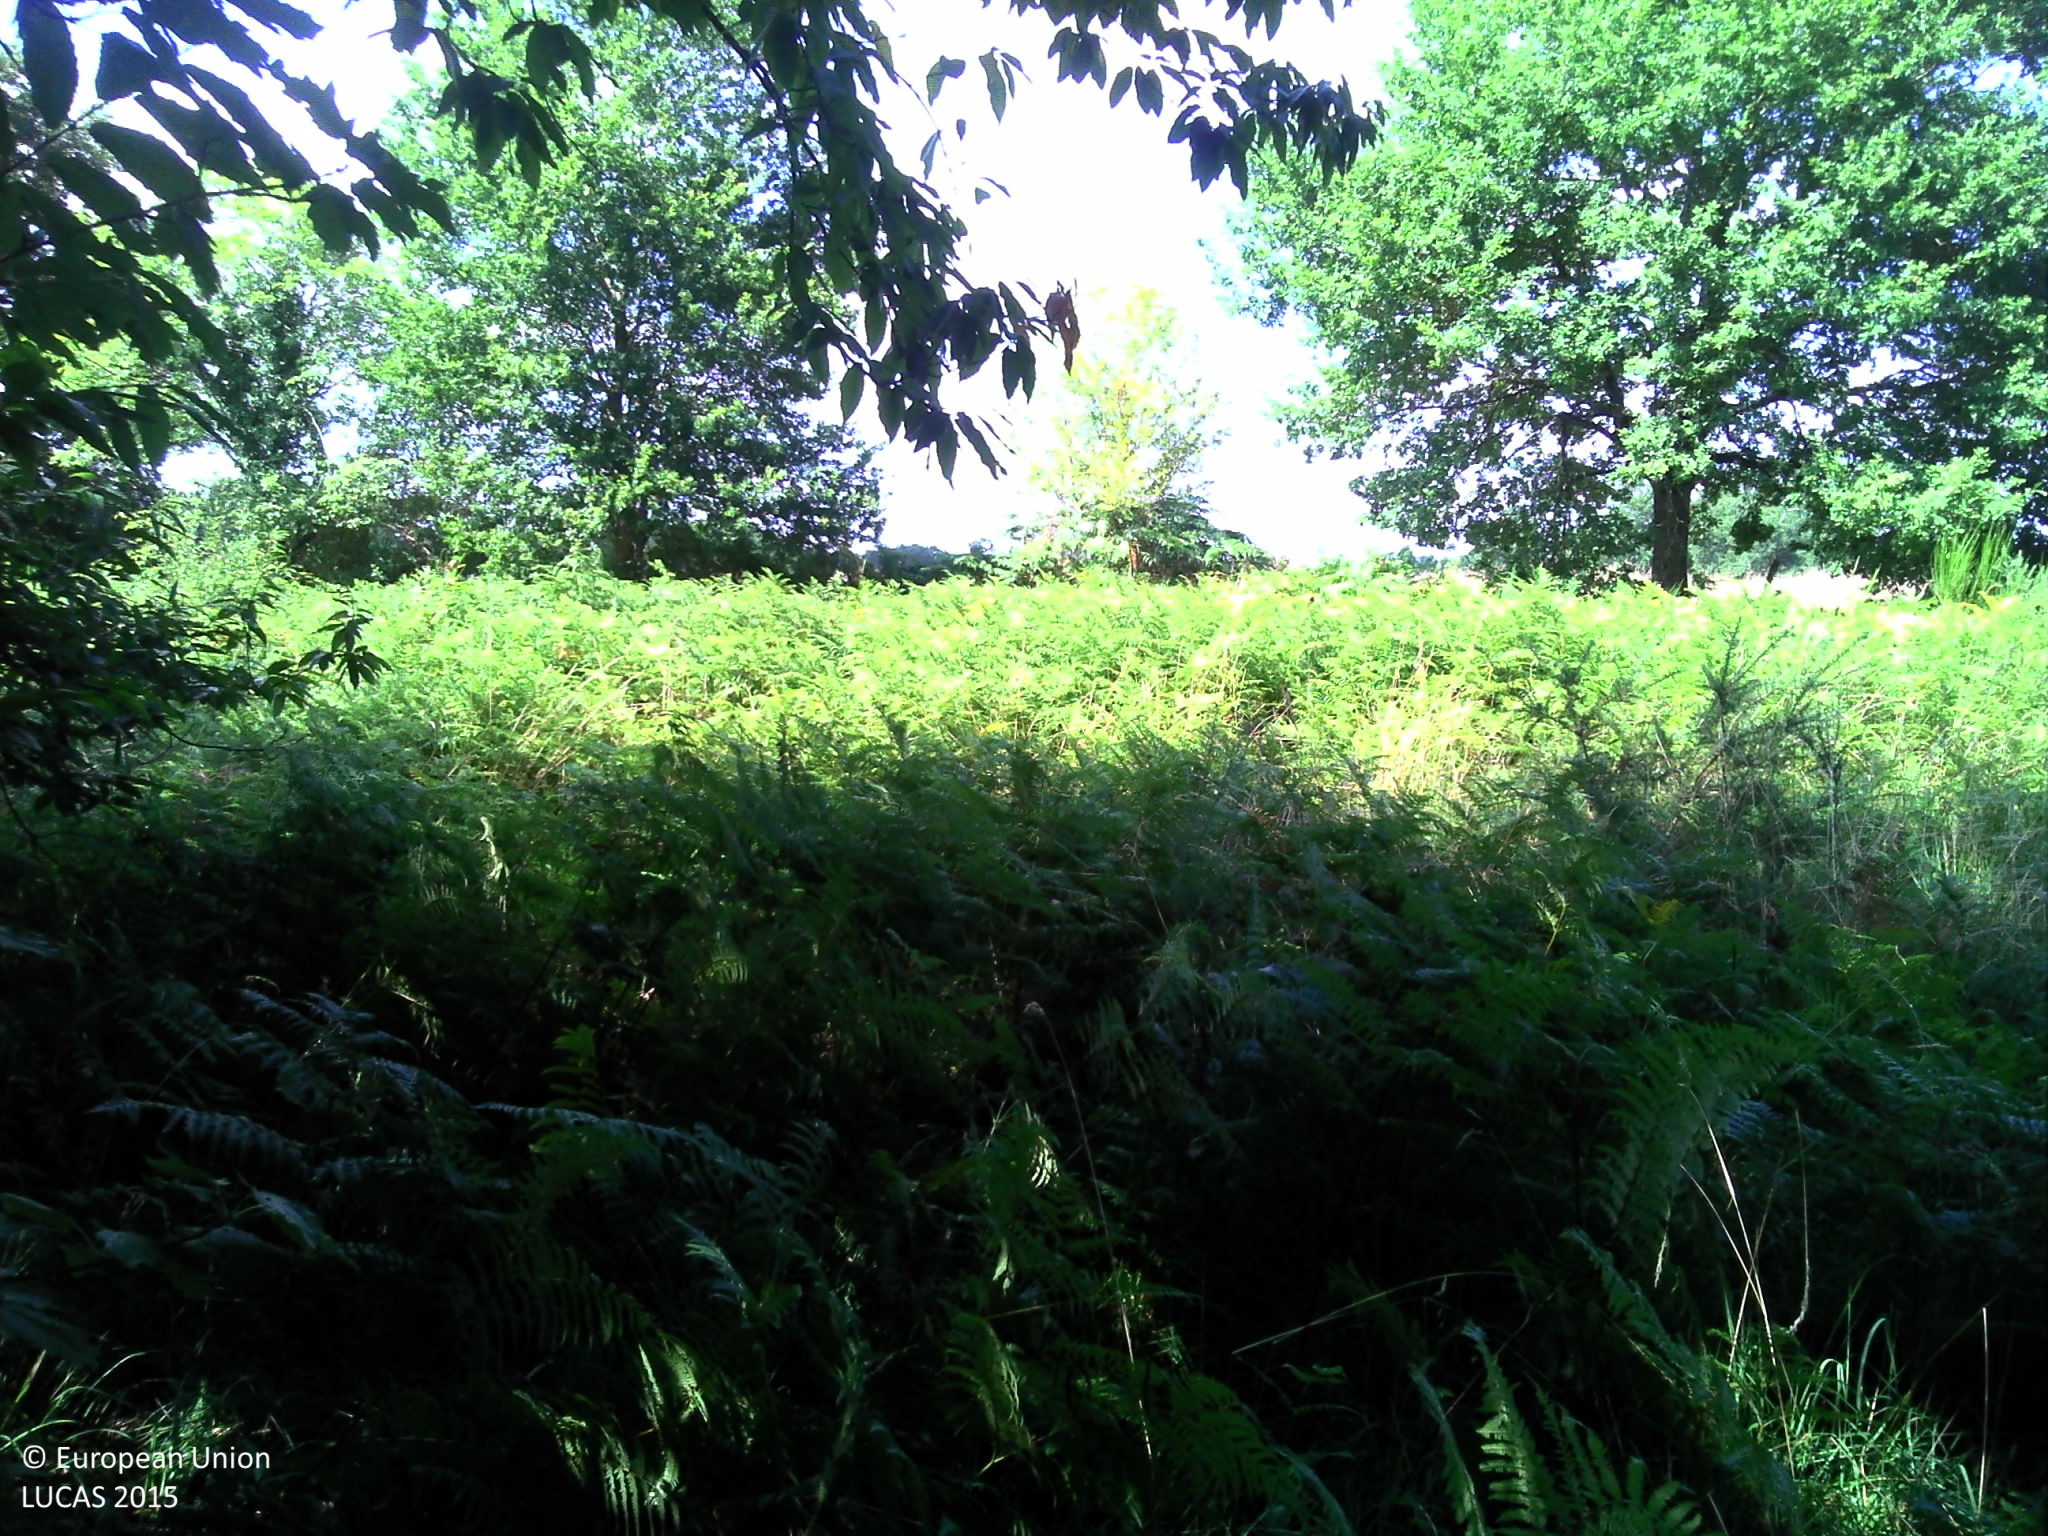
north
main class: Woodland
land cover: Broadleaved woodland
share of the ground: > 75 %
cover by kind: broadleaved forest trees 75 %, shrubs 15 %, herbaceous plants 10 %
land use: Forestry
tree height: > 5 m
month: July
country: FR
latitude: 43.8071
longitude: -0.5906
